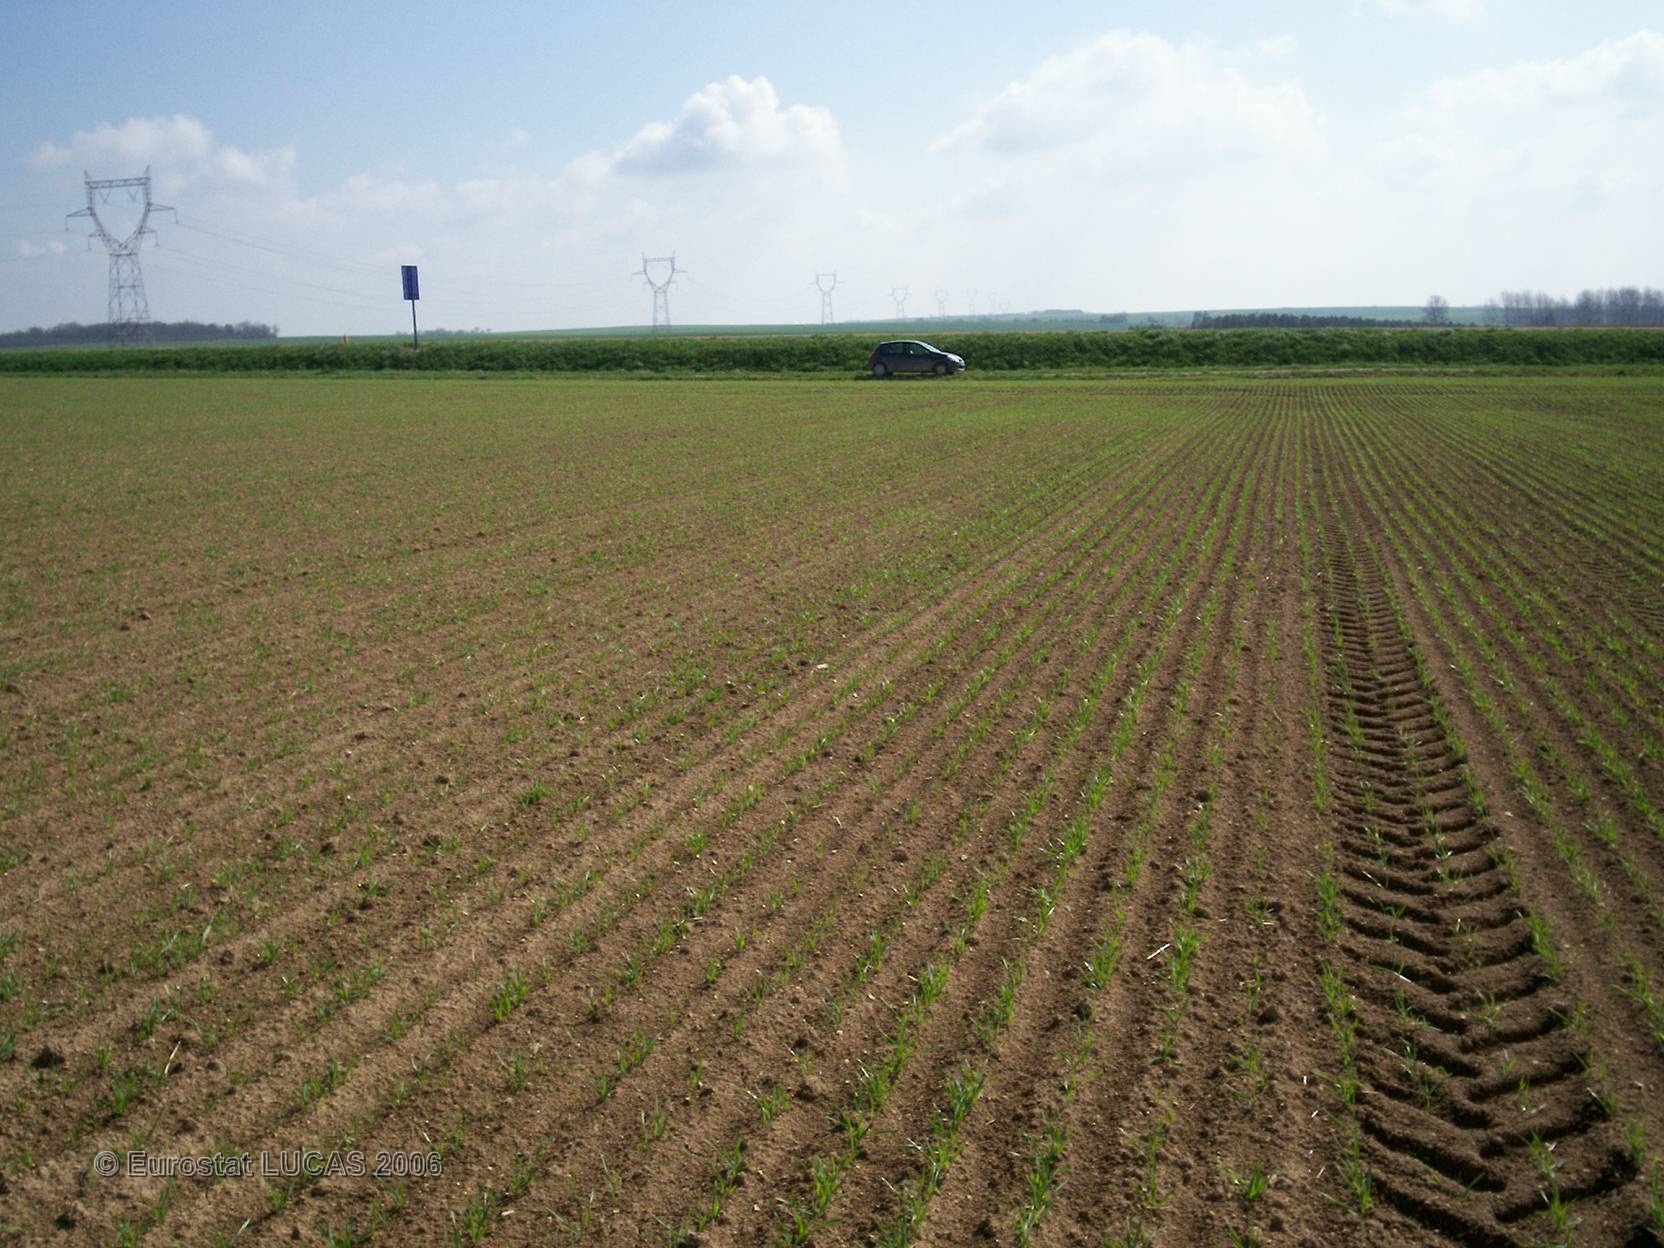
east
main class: Cropland
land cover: Barley
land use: Agriculture (excluding fallow land and kitchen gardens)
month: April
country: FR
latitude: 48.5198
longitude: 4.5140
